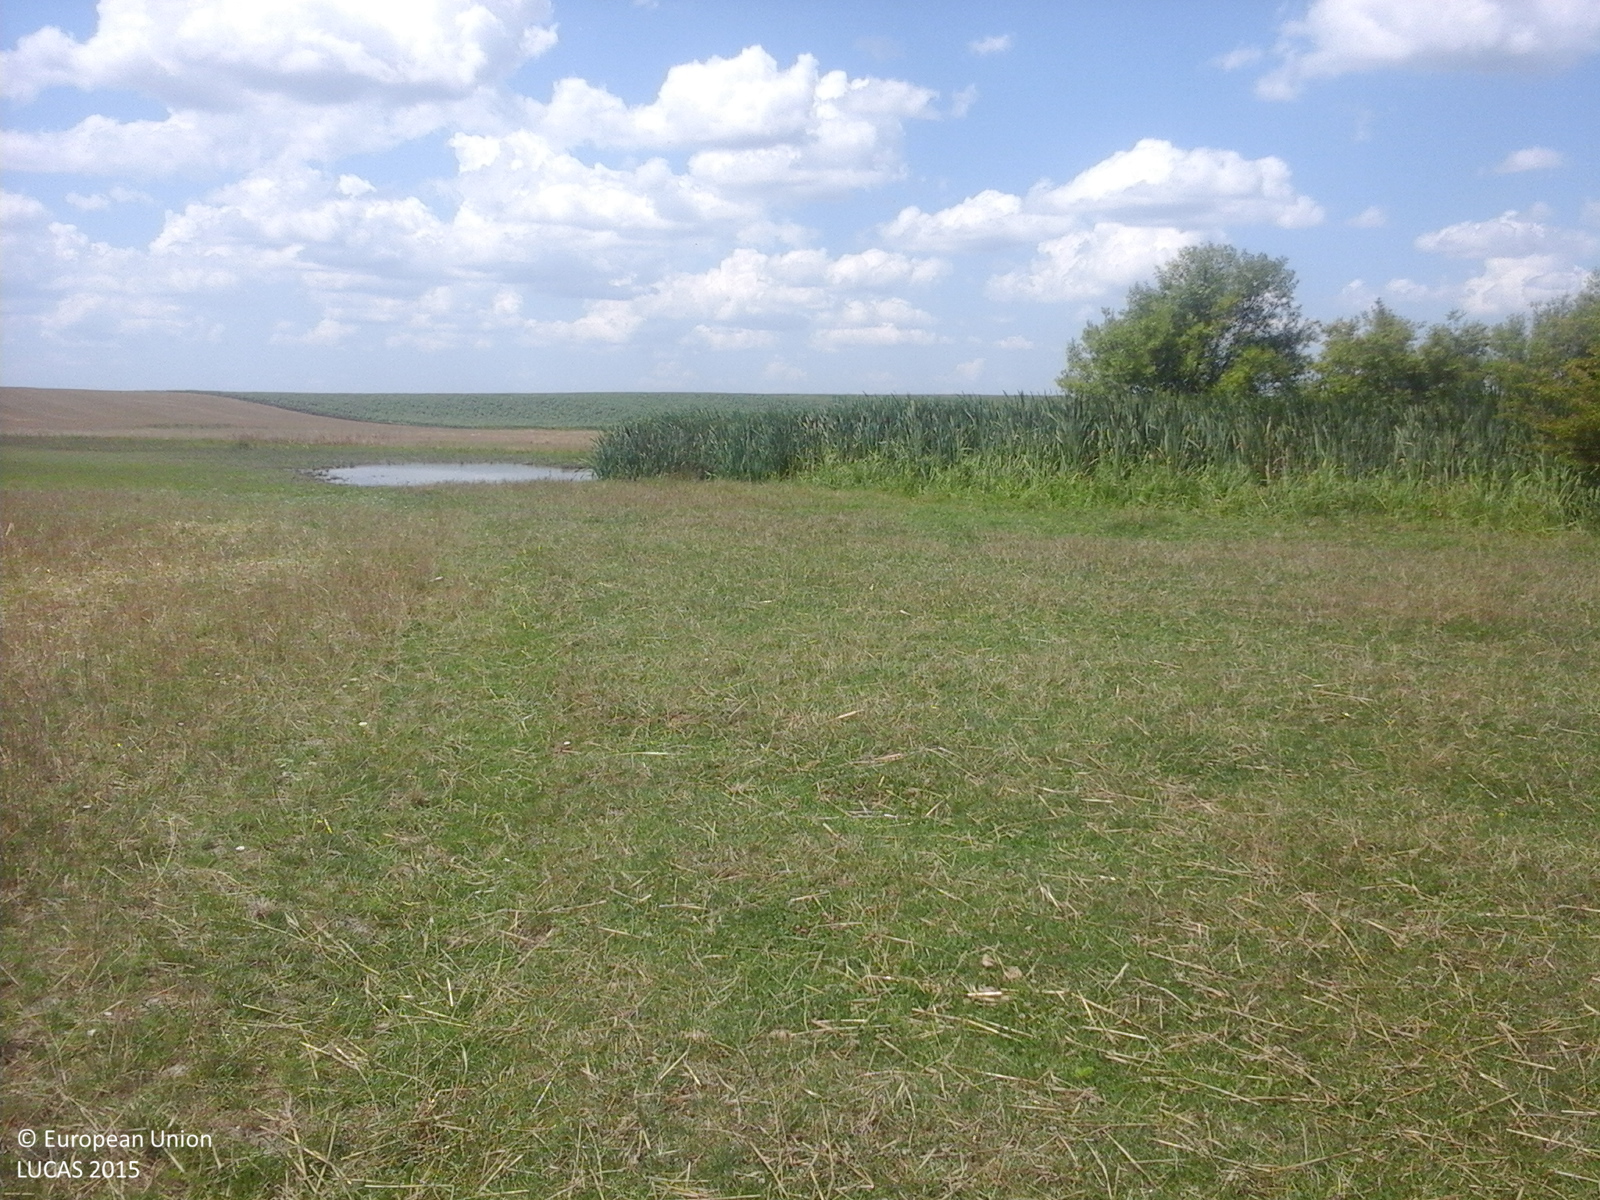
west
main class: Grassland
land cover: Grassland without tree/shrub cover
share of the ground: > 75 %
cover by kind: herbaceous plants 100 %
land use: Agriculture (excluding fallow land and kitchen gardens)
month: July
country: RO
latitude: 44.3069
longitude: 24.9326
